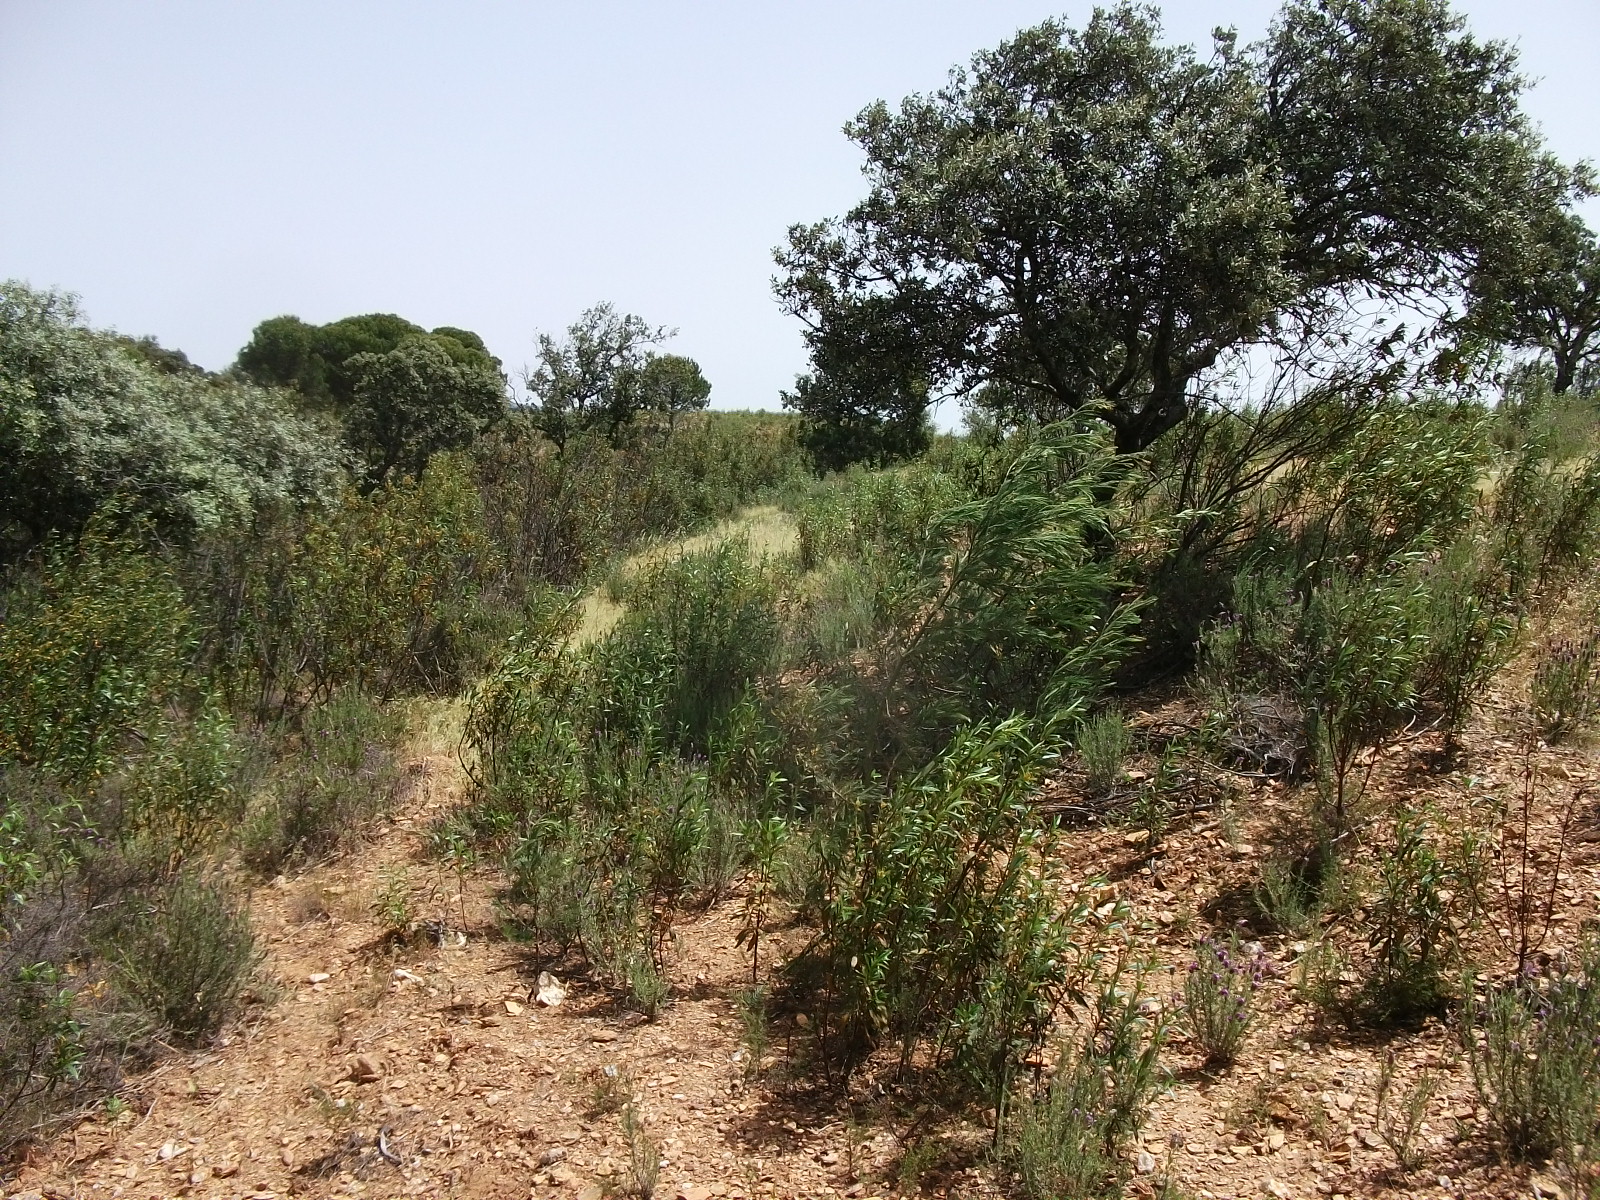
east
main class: Grassland
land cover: Grassland with sparse tree/shrub cover
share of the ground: 25 - 50 %
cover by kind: herbaceous plants 85 %, shrubs 10 %, broadleaved forest trees 5 %
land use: Agriculture (excluding fallow land and kitchen gardens)
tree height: < 5 m
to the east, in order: Grassland with sparse tree/shrub cover; Broadleaved woodland; Shrubland without tree cover; Broadleaved woodland; Shruby margins; Fences; Broadleaved woodland; Grassland without tree/shrub cover; Shruby margins; Fences; Broadleaved woodland
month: May
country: ES
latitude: 37.7981
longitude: -7.0755
